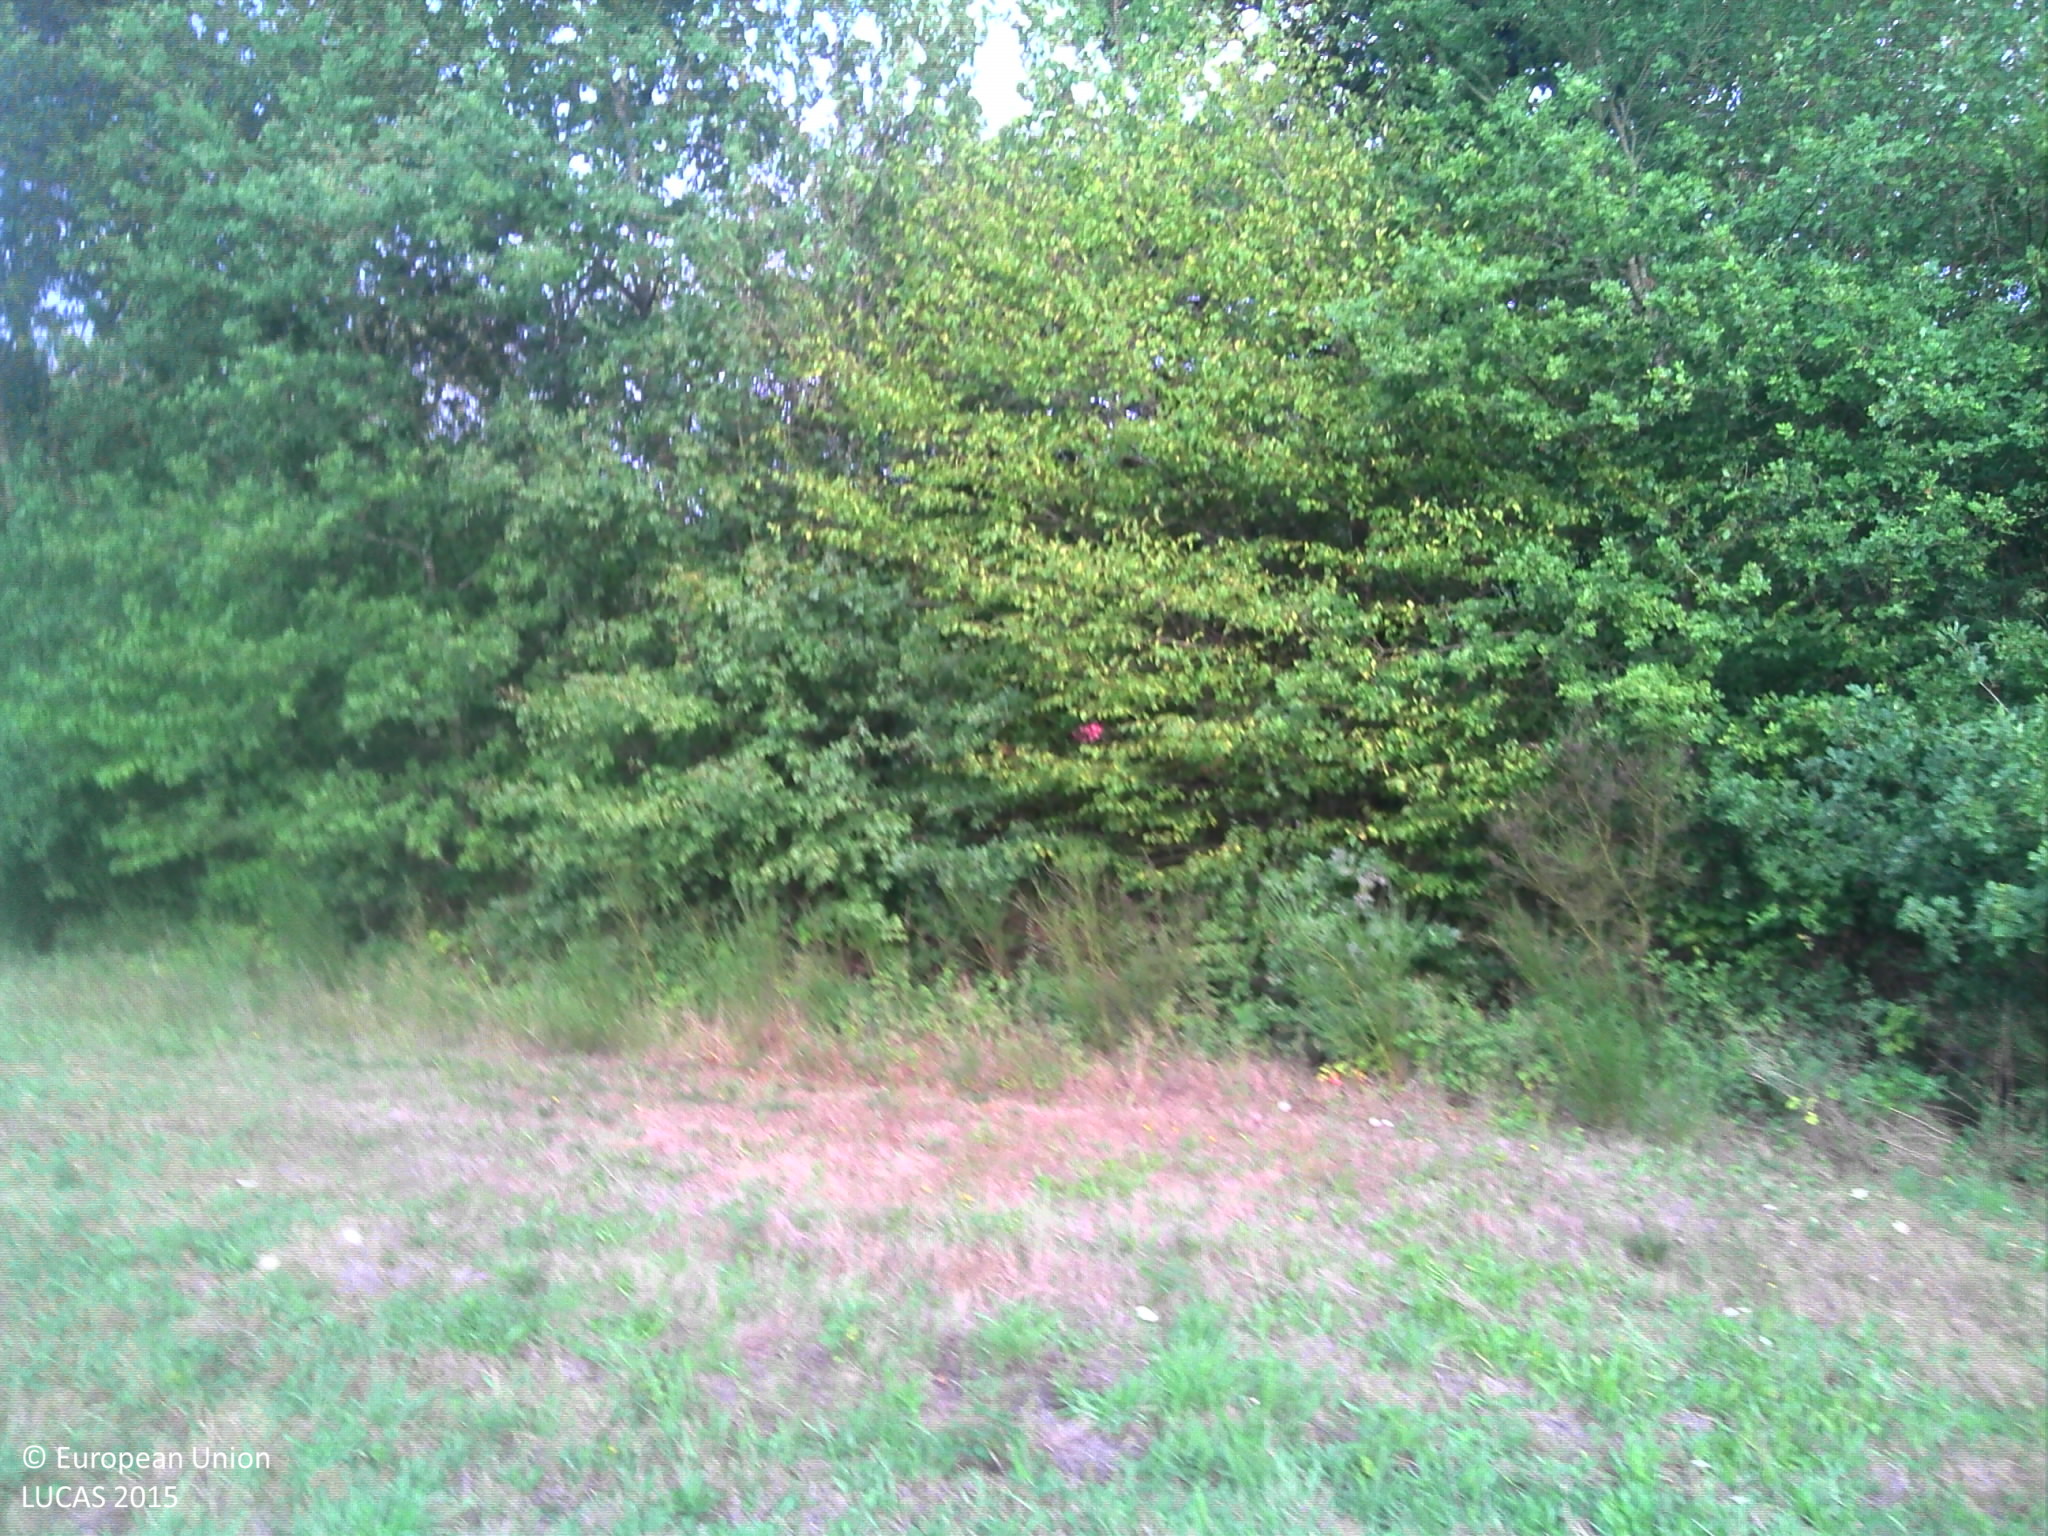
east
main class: Grassland
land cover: Grassland without tree/shrub cover
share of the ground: > 75 %
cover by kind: herbaceous plants 100 %
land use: Agriculture (excluding fallow land and kitchen gardens)
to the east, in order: Grassland without tree/shrub cover; Broadleaved woodland; Fences; Ditches and canals; Paved roads, cycling and walking lanes; Grass margins; Broadleaved woodland; Fences; Conifer hedges; Grassland with sparse tree/shrub cover; Artificial constructions in urban areas; Grassland with sparse tree/shrub cover; Rivers and streams; Grassland with sparse tree/shrub cover; Inland fresh water bodies; Broadleaved woodland; Fences; Other bare soil
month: September
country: FR
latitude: 48.4201
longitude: 0.8303
